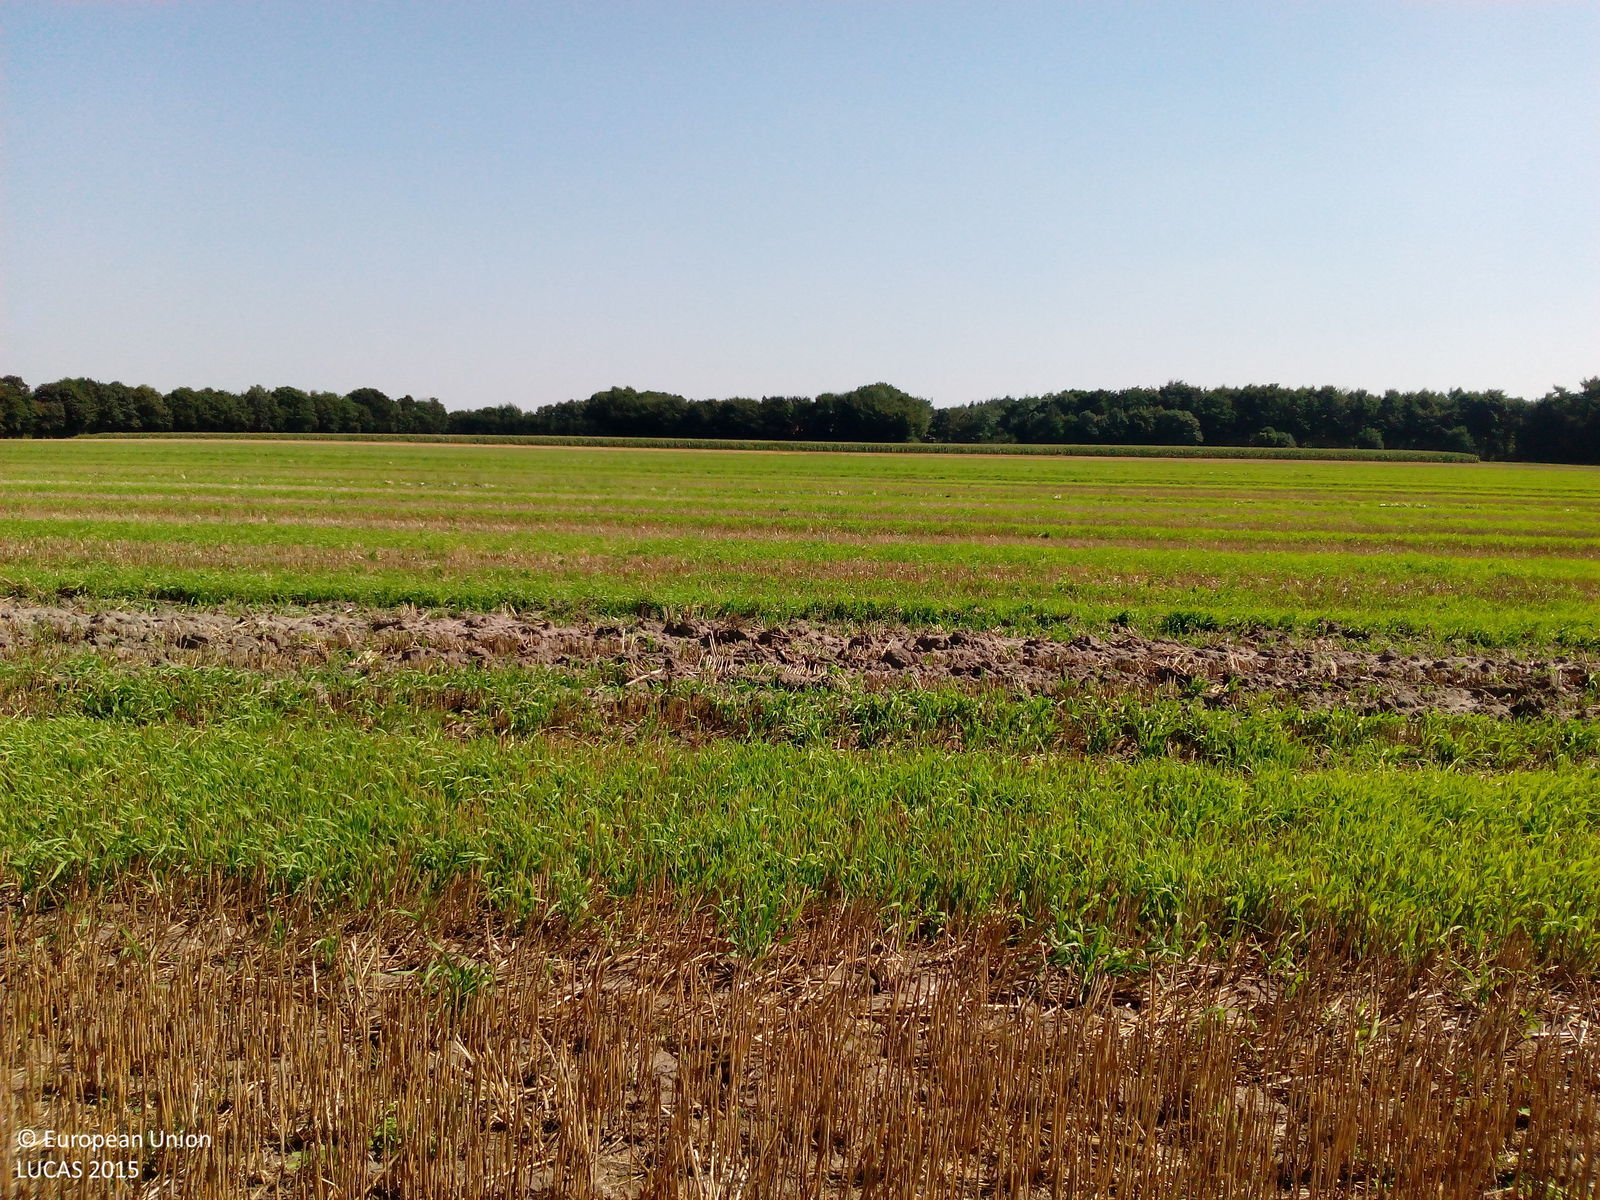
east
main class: Cropland
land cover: Barley
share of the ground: > 75 %
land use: Agriculture (excluding fallow land and kitchen gardens)
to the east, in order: Barley; Common wheat
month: August
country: DE
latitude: 52.7562
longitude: 8.0002
